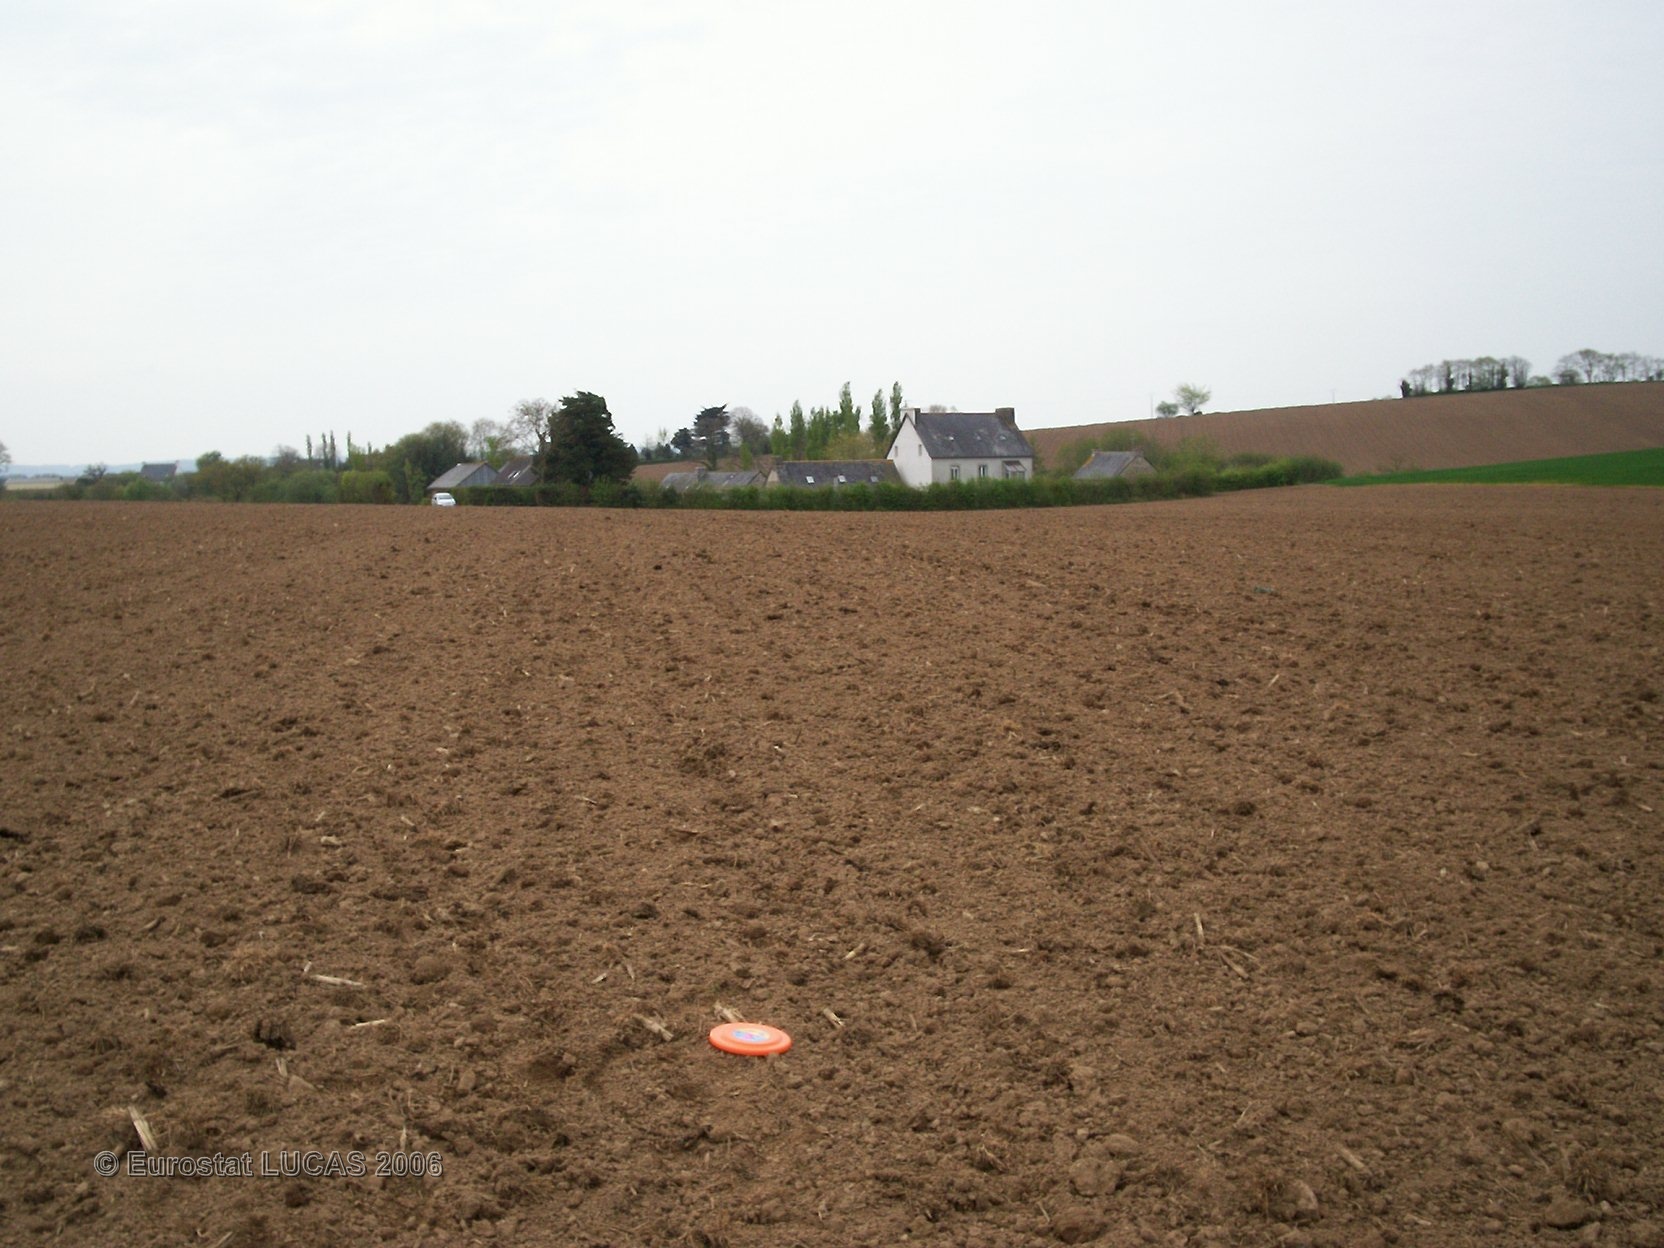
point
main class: Cropland
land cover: Maize
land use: Agriculture (excluding fallow land and kitchen gardens)
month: May
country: FR
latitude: 48.2273
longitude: -3.9383
